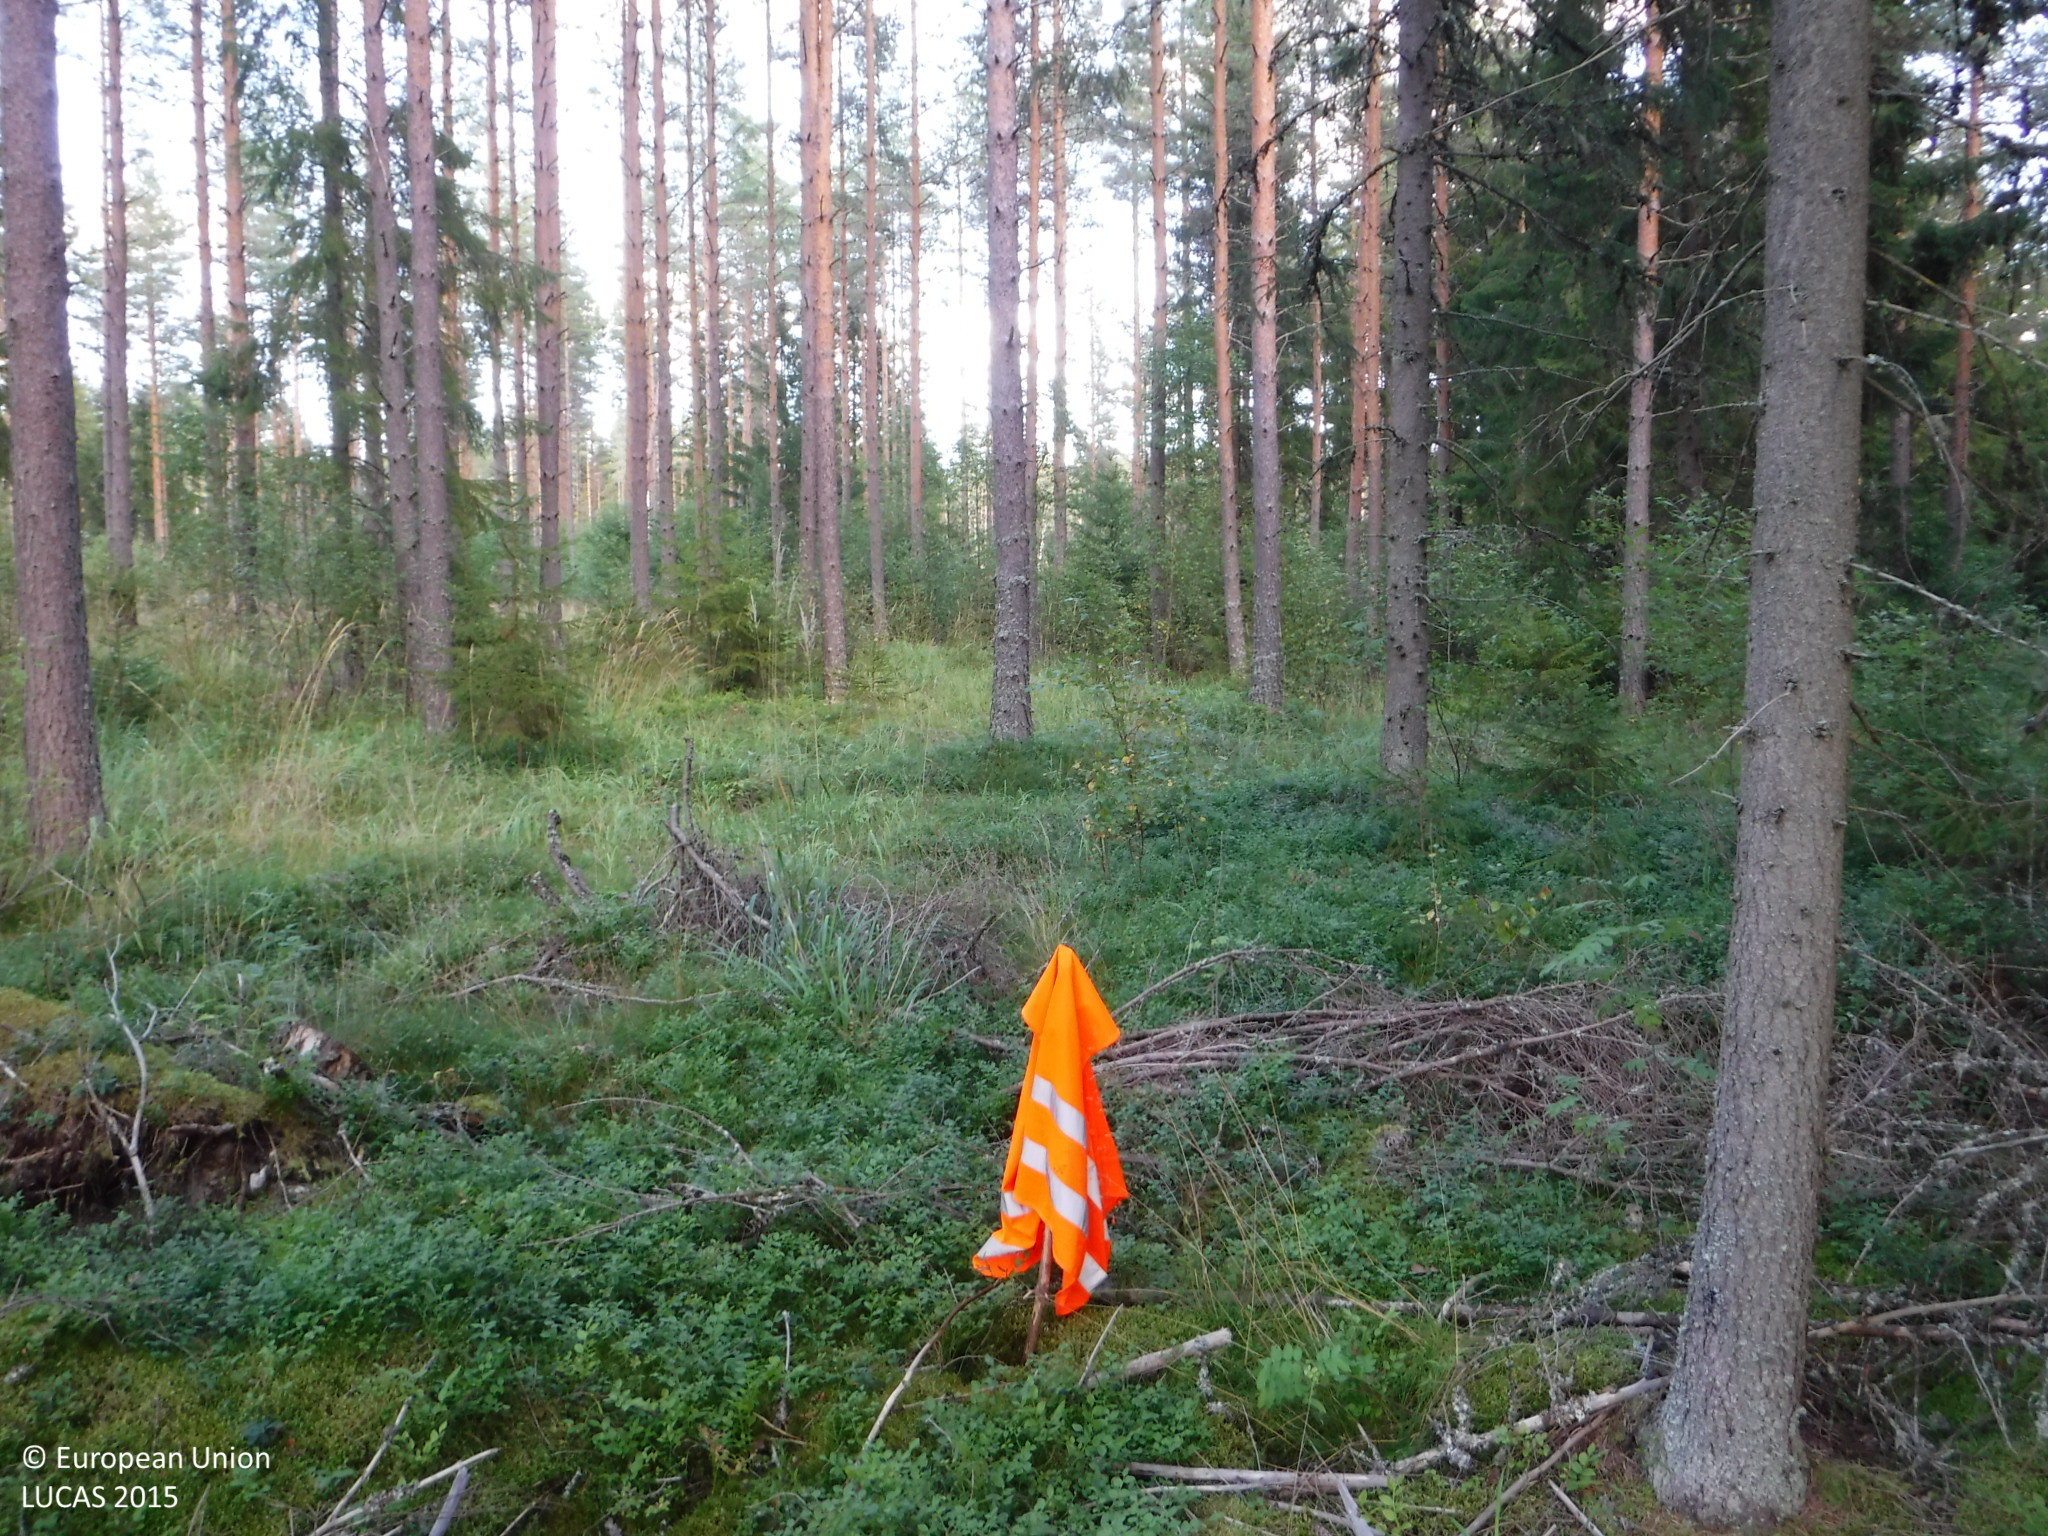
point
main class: Woodland
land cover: Spruce dominated coniferous woodland
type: boreal forest
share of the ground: 50 - 75 %
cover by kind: coniferous forest trees 50 %, shrubs 40 %, lichens and mosses 10 %
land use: Forestry
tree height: > 5 m
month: August
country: FI
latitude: 61.1885
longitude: 21.9064
